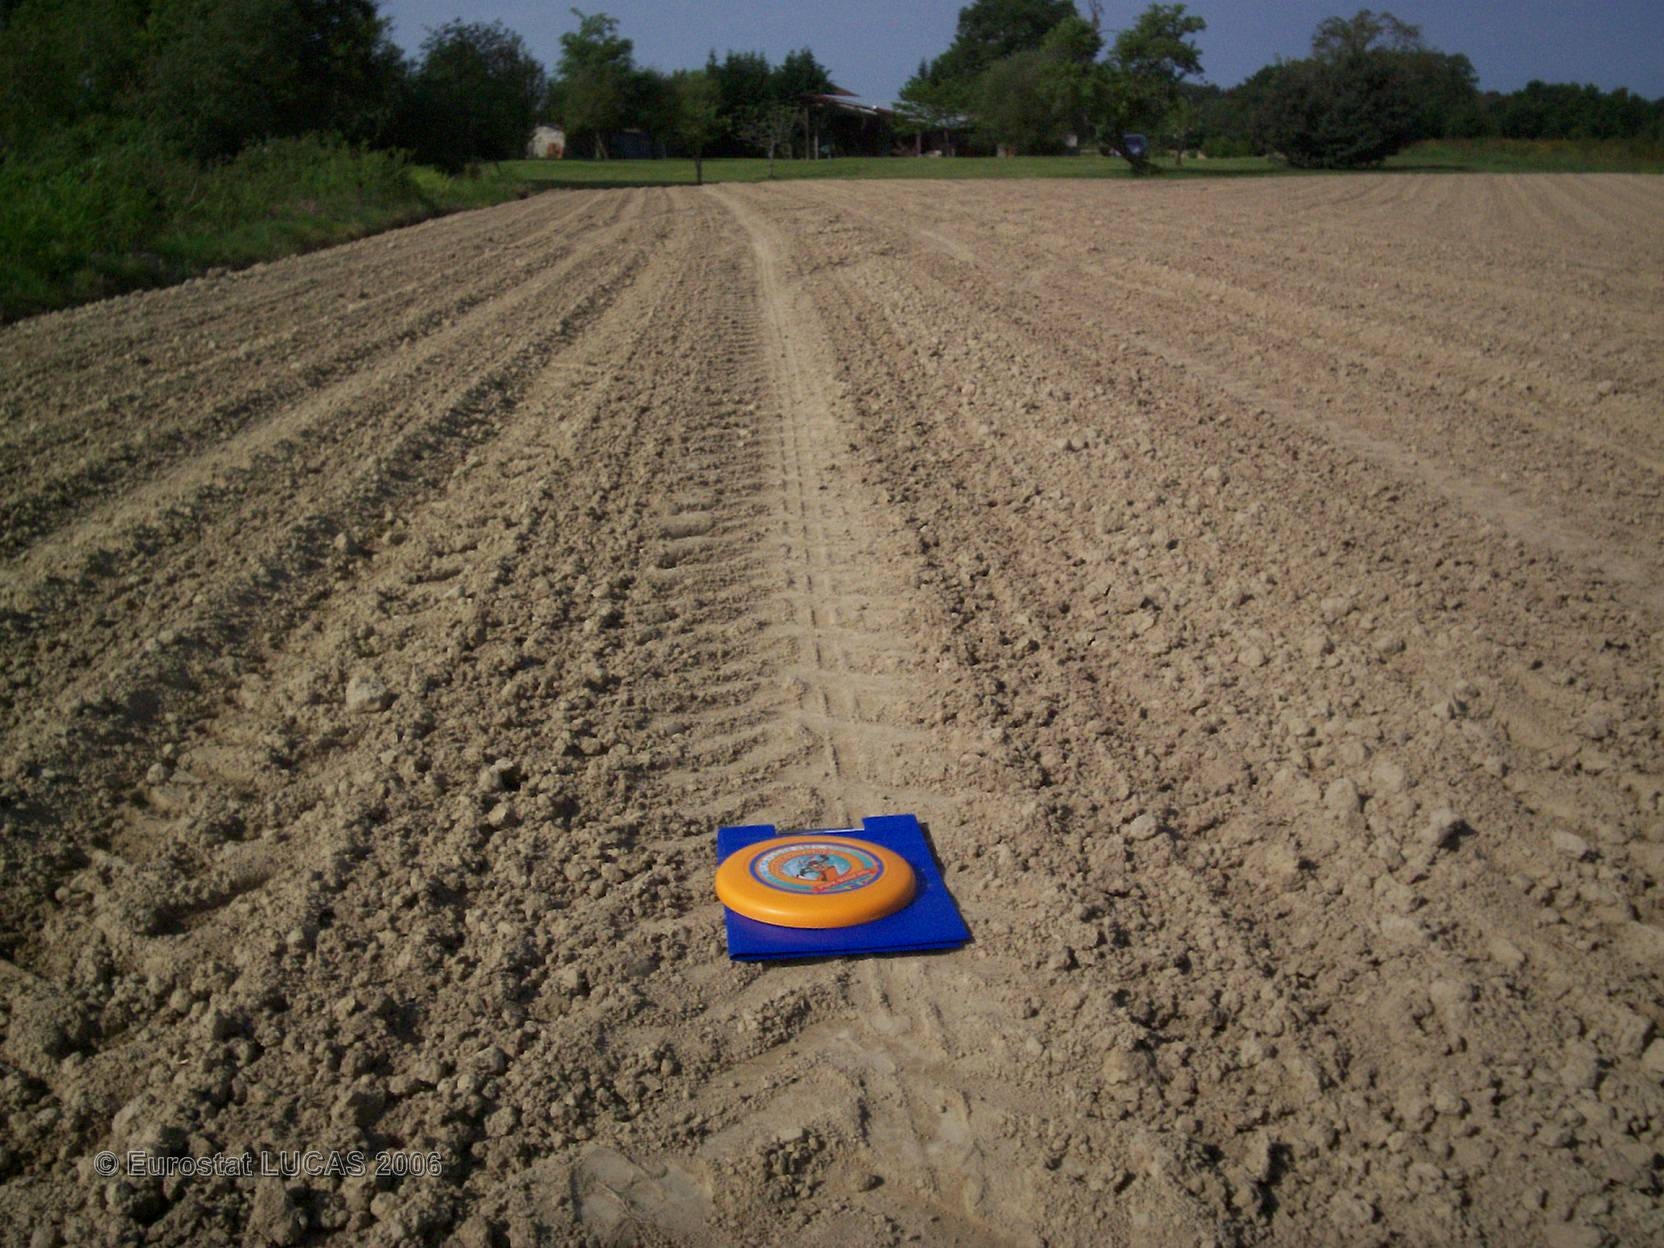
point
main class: Cropland
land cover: Maize
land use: Agriculture (excluding fallow land and kitchen gardens)
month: June
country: FR
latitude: 43.7380
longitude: -0.3775
